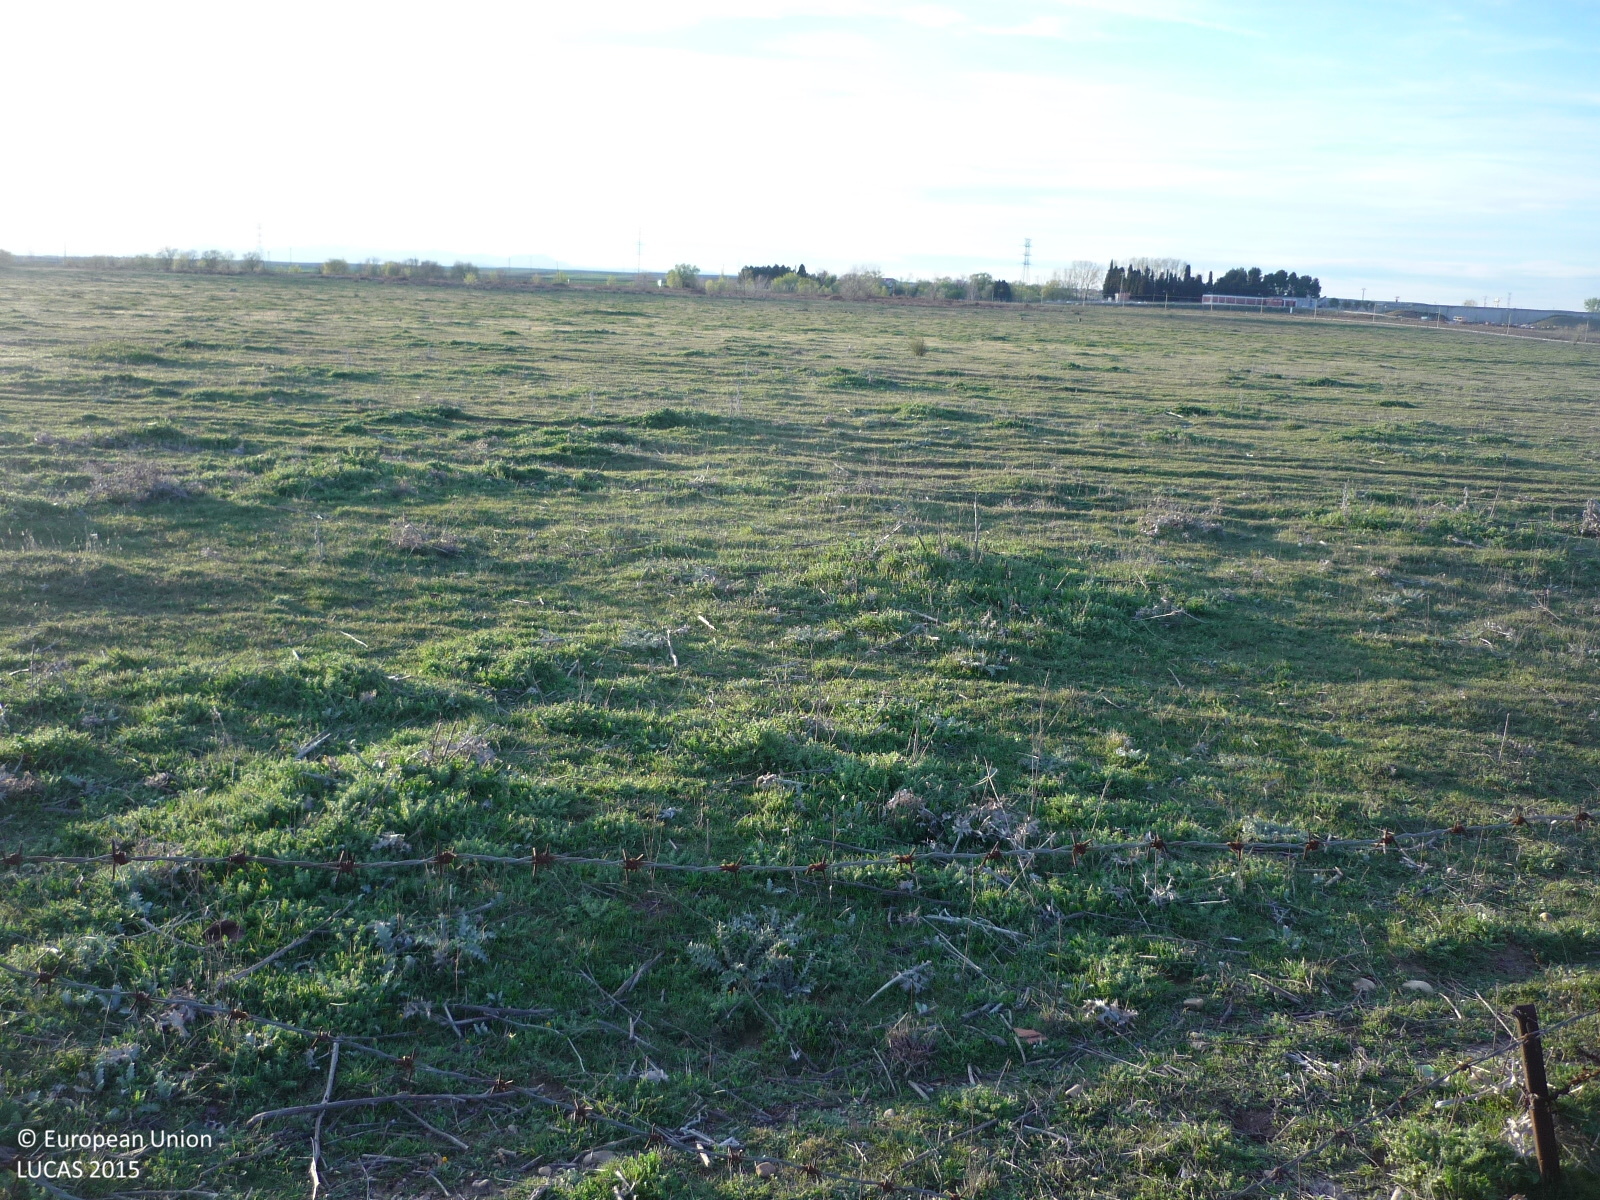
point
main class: Grassland
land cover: Grassland without tree/shrub cover
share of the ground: > 75 %
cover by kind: herbaceous plants 100 %
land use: Semi-natural and natural areas not in use
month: March
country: ES
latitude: 40.5239
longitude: -3.3372
